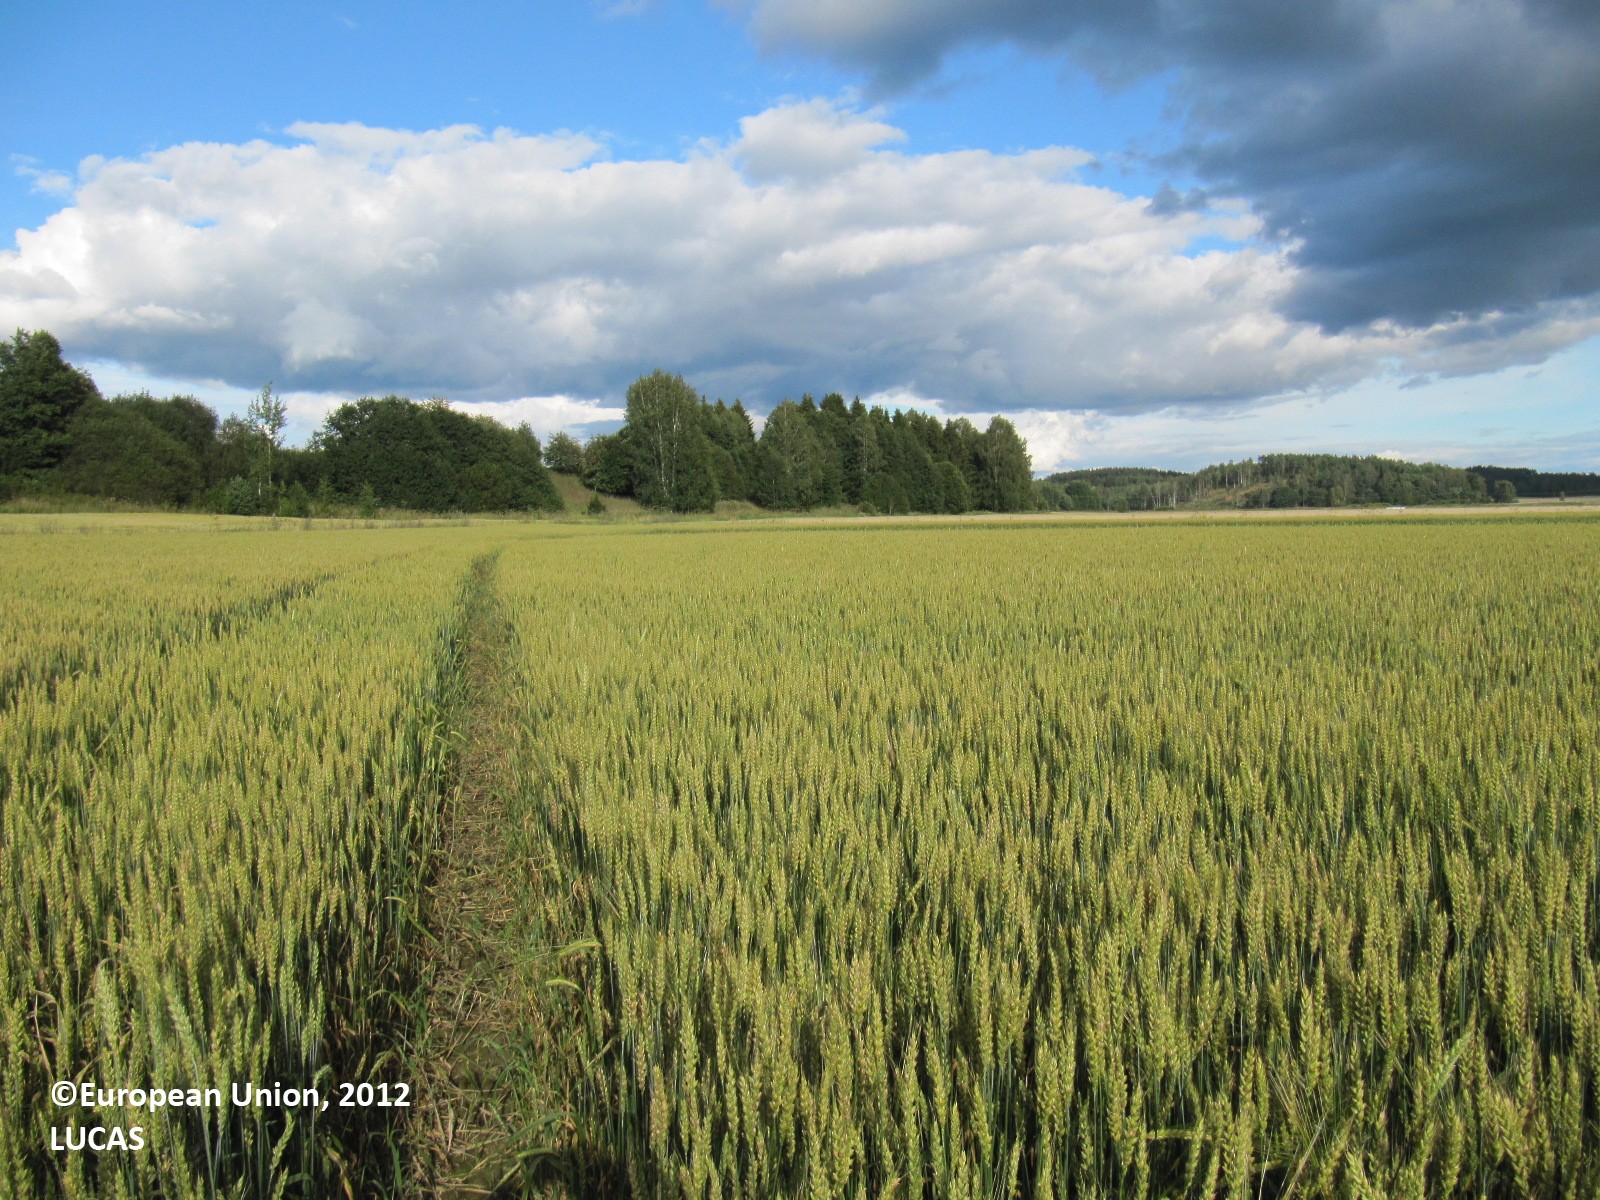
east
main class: Cropland
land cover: Common wheat
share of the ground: > 75 %
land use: Agriculture (excluding fallow land and kitchen gardens)
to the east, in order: Common wheat; Sugar beet; Common wheat; Grass margins; Ditches and canals; Grass margins; Barley
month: August
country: FI
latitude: 60.3240
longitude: 23.2107
